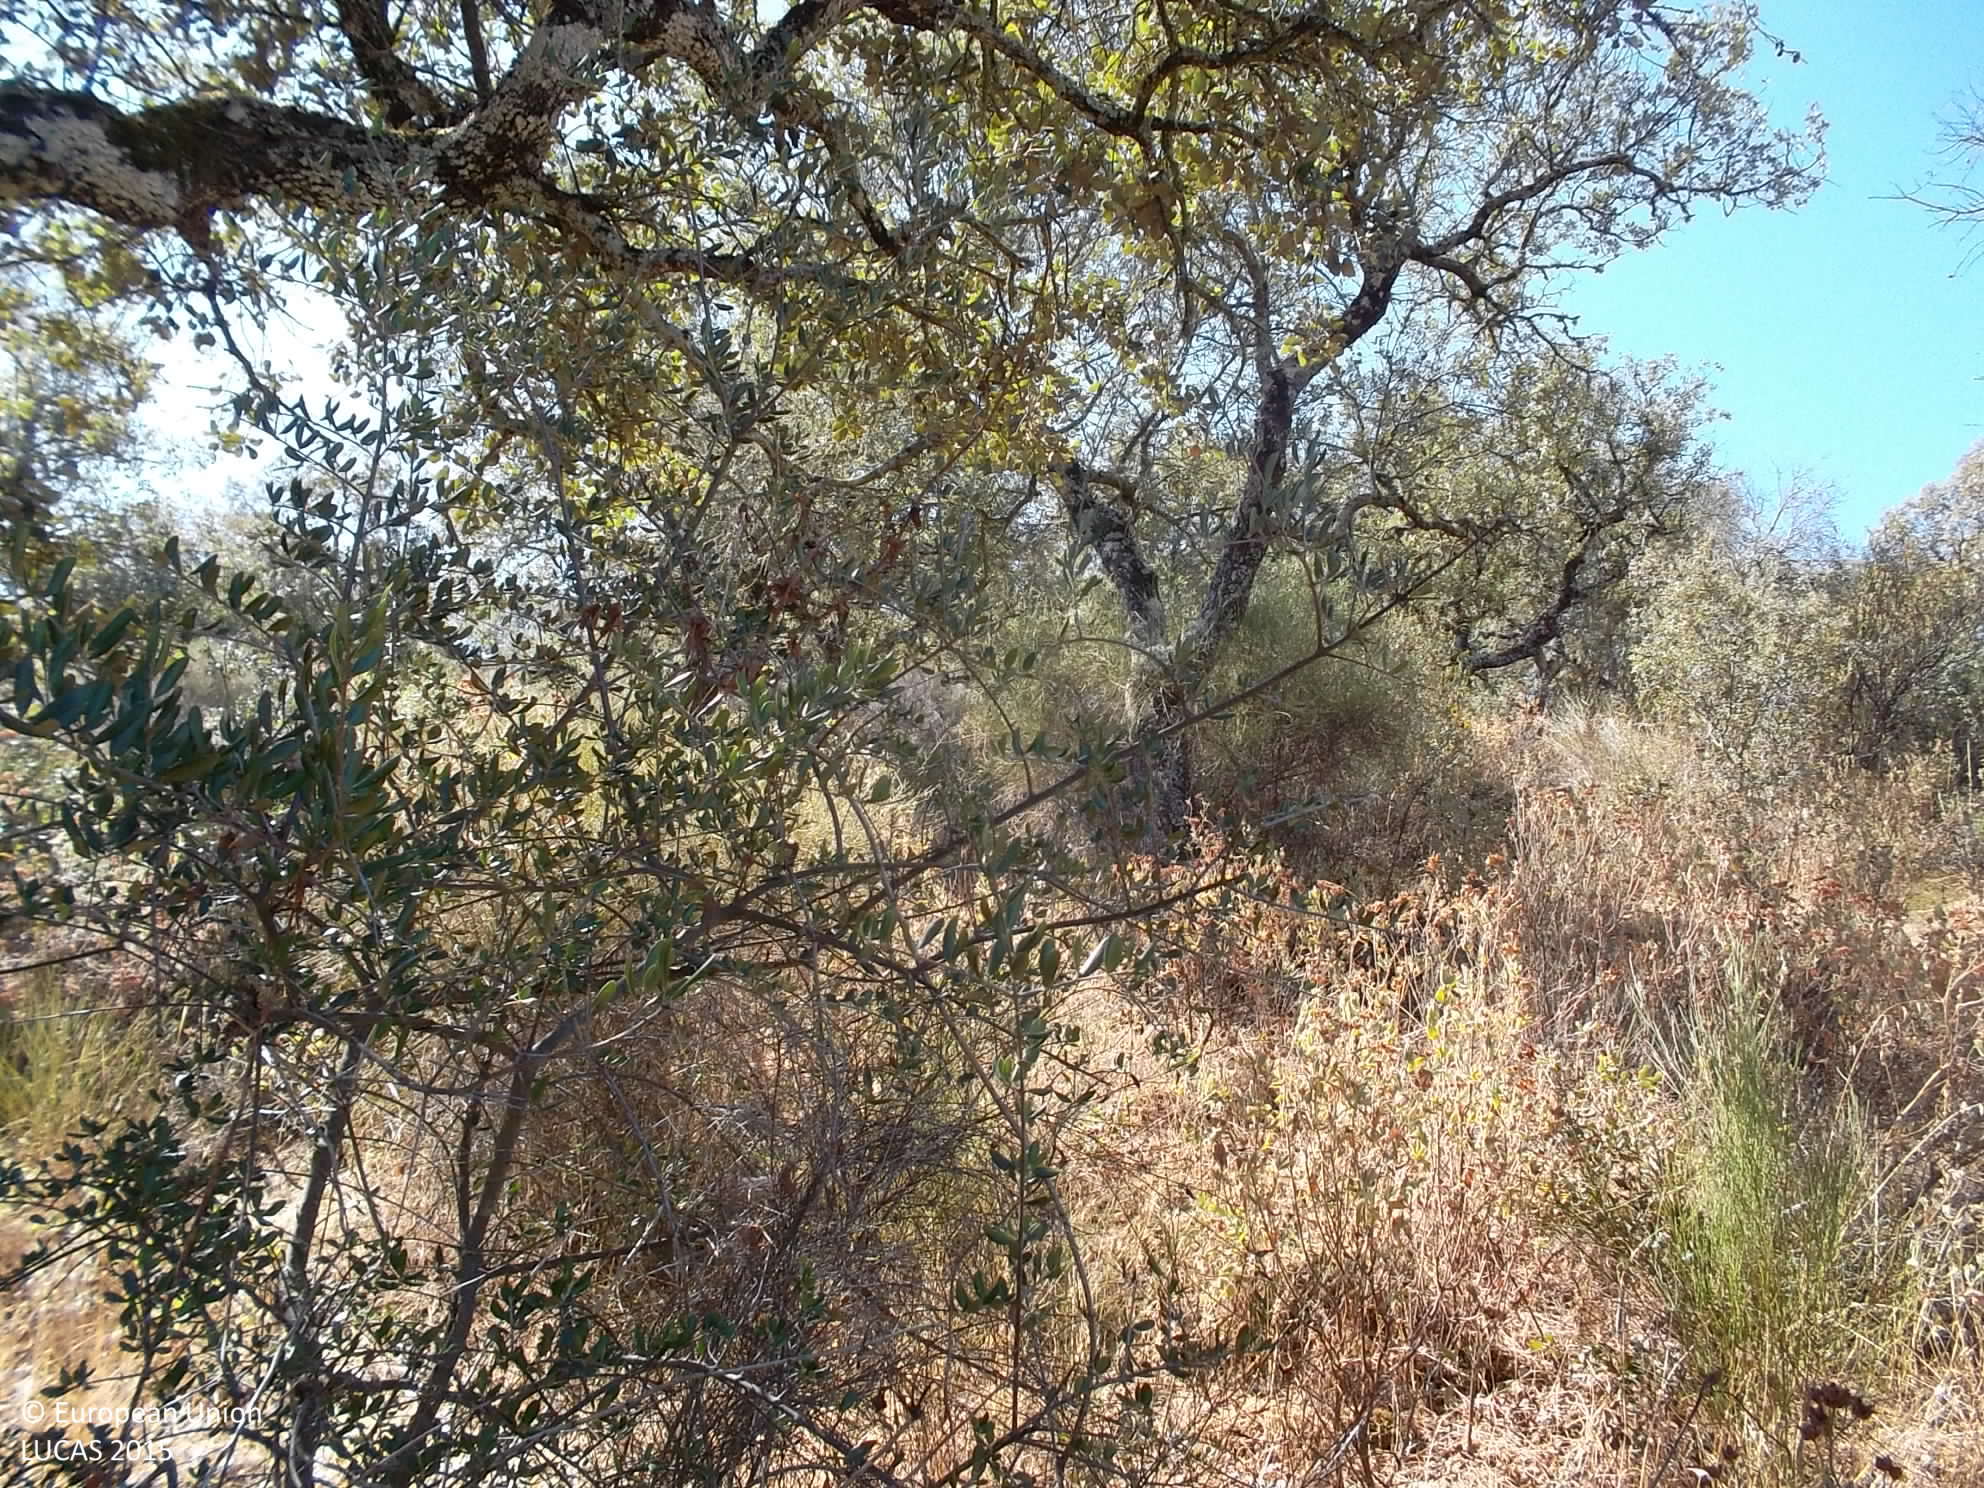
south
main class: Woodland
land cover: Broadleaved woodland
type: broadleaved evergreen forest
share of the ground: 25 - 50 %
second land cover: Shrubland without tree cover
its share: 25 - 50 %
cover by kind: broadleaved forest trees 40 %, shrubs 40 %, herbaceous plants 20 %
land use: Forestry
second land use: Agriculture (excluding fallow land and kitchen gardens)
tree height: < 5 m
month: August
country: ES
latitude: 38.5331
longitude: -6.6799
